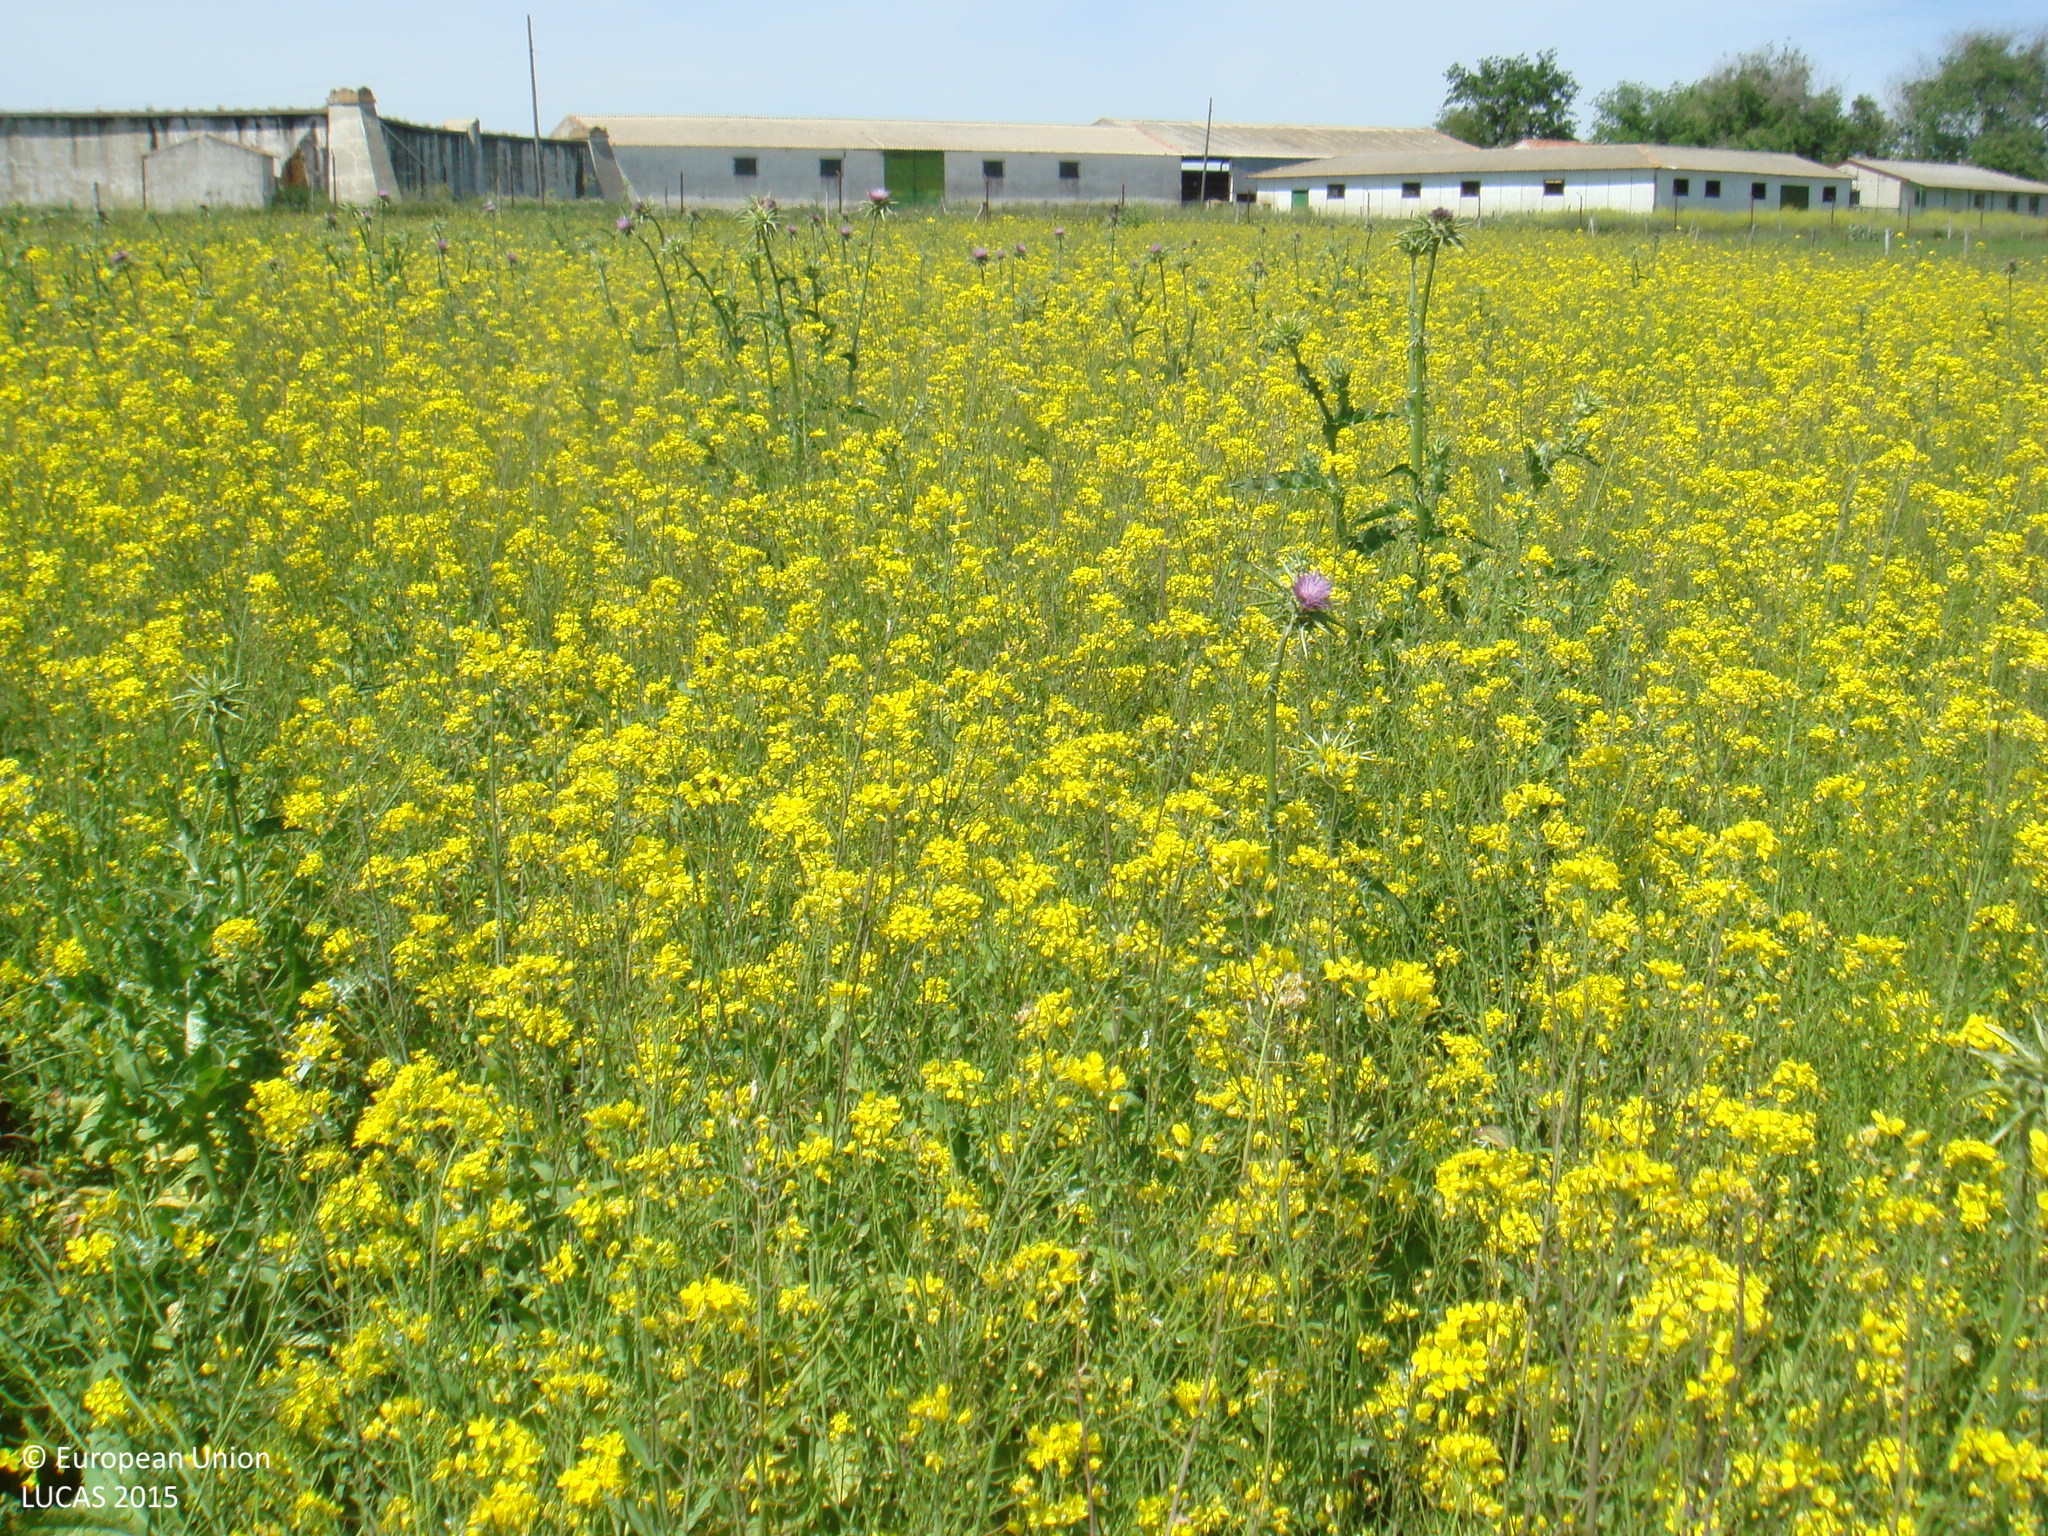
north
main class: Grassland
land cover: Spontaneously vegetated surfaces
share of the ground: > 75 %
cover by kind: herbaceous plants 95 %, shrubs 5 %
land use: Fallow land
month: April
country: ES
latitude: 38.5017
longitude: -5.1079
